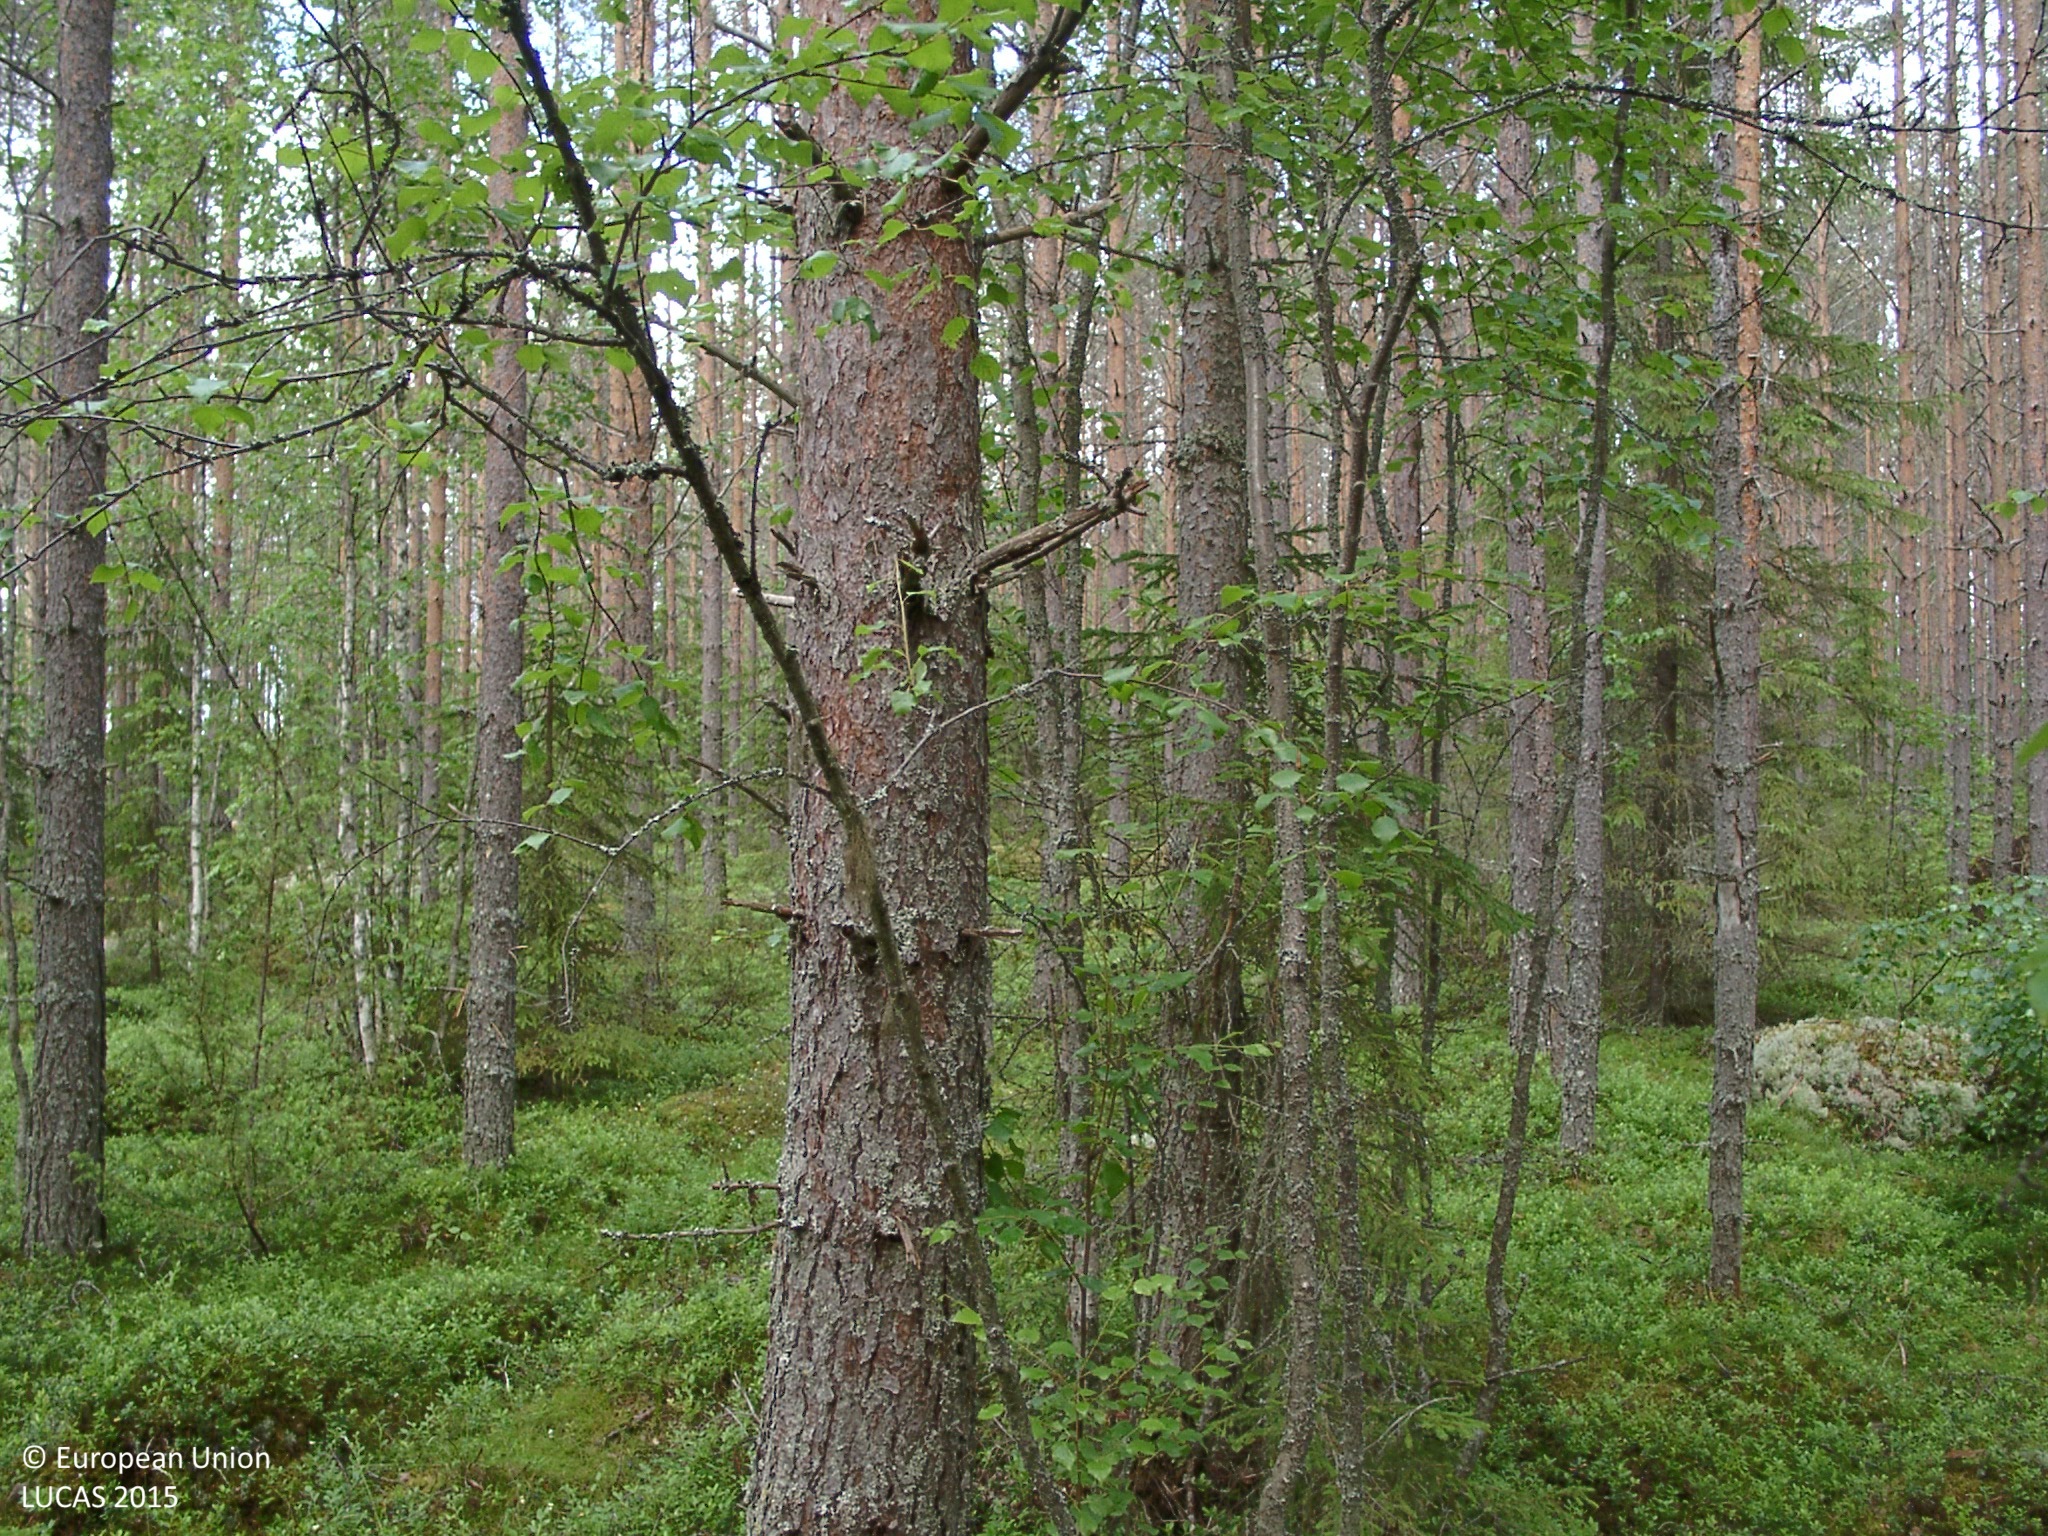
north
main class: Woodland
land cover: Other mixed woodland
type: boreal forest
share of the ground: 50 - 75 %
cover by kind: coniferous forest trees 55 %, broadleaved forest trees 20 %, shrubs 20 %, lichens and mosses 5 %
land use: Semi-natural and natural areas not in use
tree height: > 5 m
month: July
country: FI
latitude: 62.1580
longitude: 25.0955
